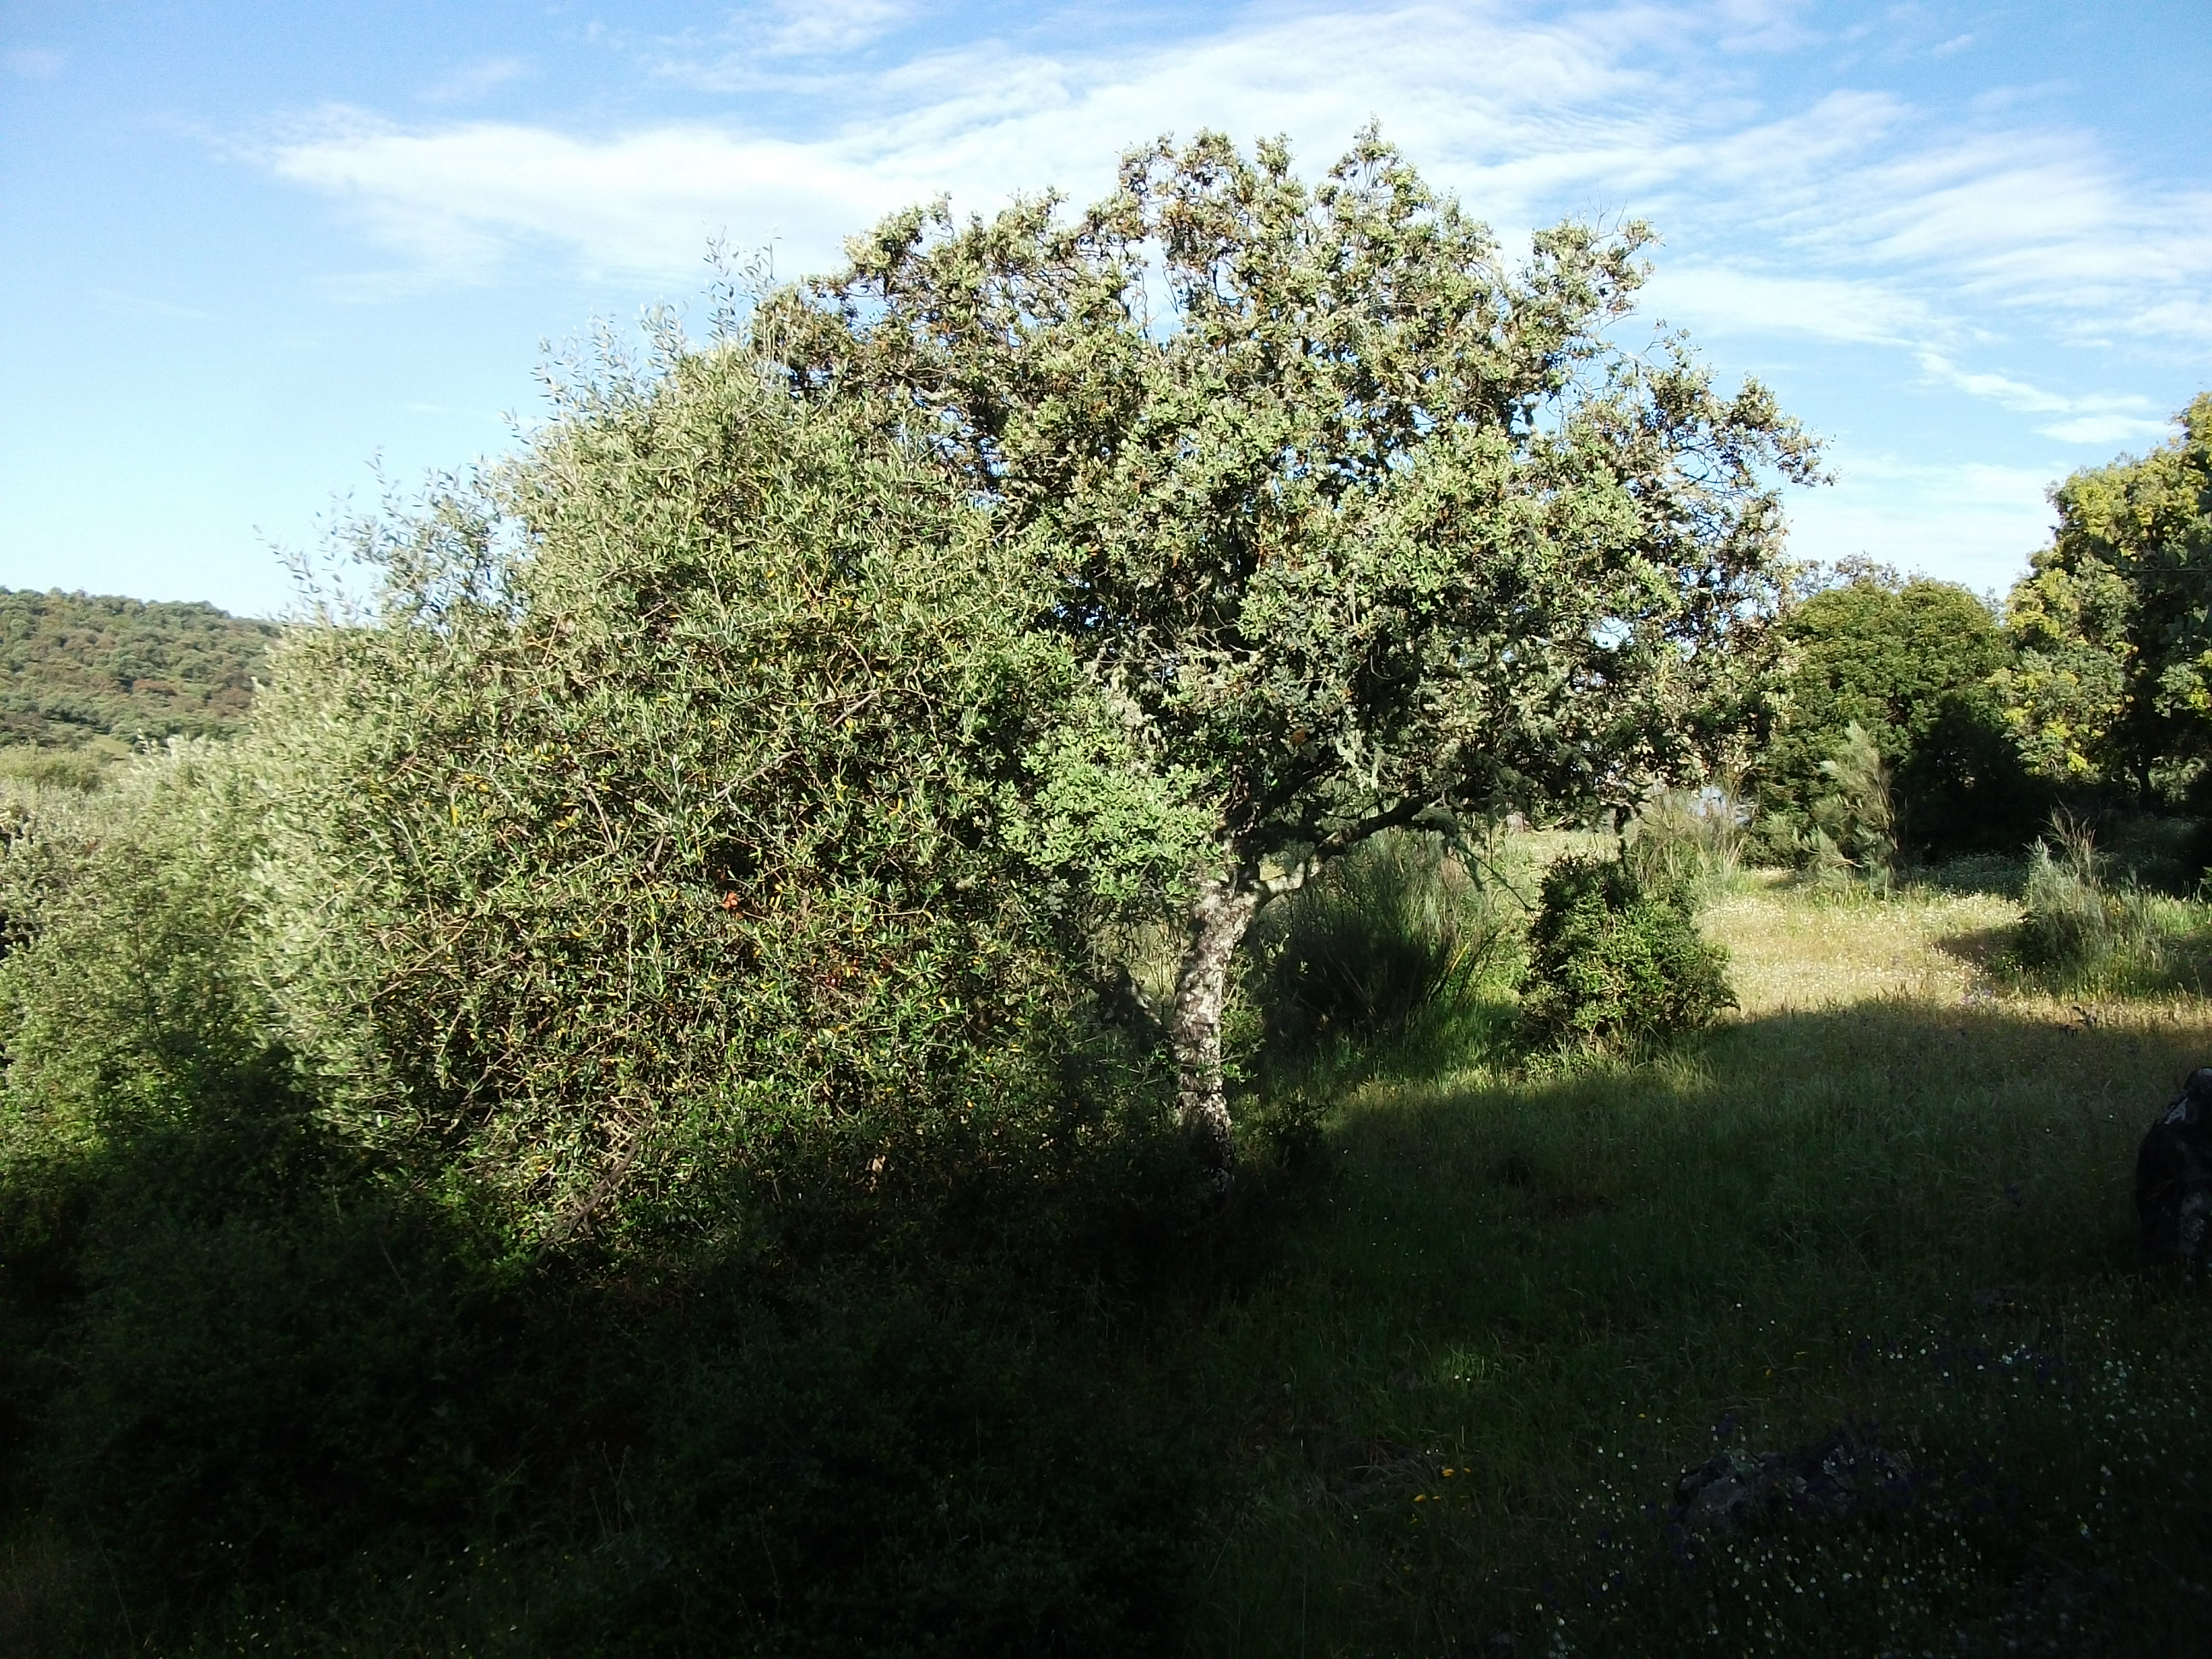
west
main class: Woodland
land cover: Broadleaved woodland
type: broadleaved evergreen forest
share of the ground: 25 - 50 %
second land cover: Spontaneously vegetated surfaces
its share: 25 - 50 %
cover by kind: broadleaved forest trees 40 %, shrubs 30 %, herbaceous plants 30 %
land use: Forestry
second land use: Agriculture (excluding fallow land and kitchen gardens)
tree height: > 5 m
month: April
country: ES
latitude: 38.0425
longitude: -6.7427
